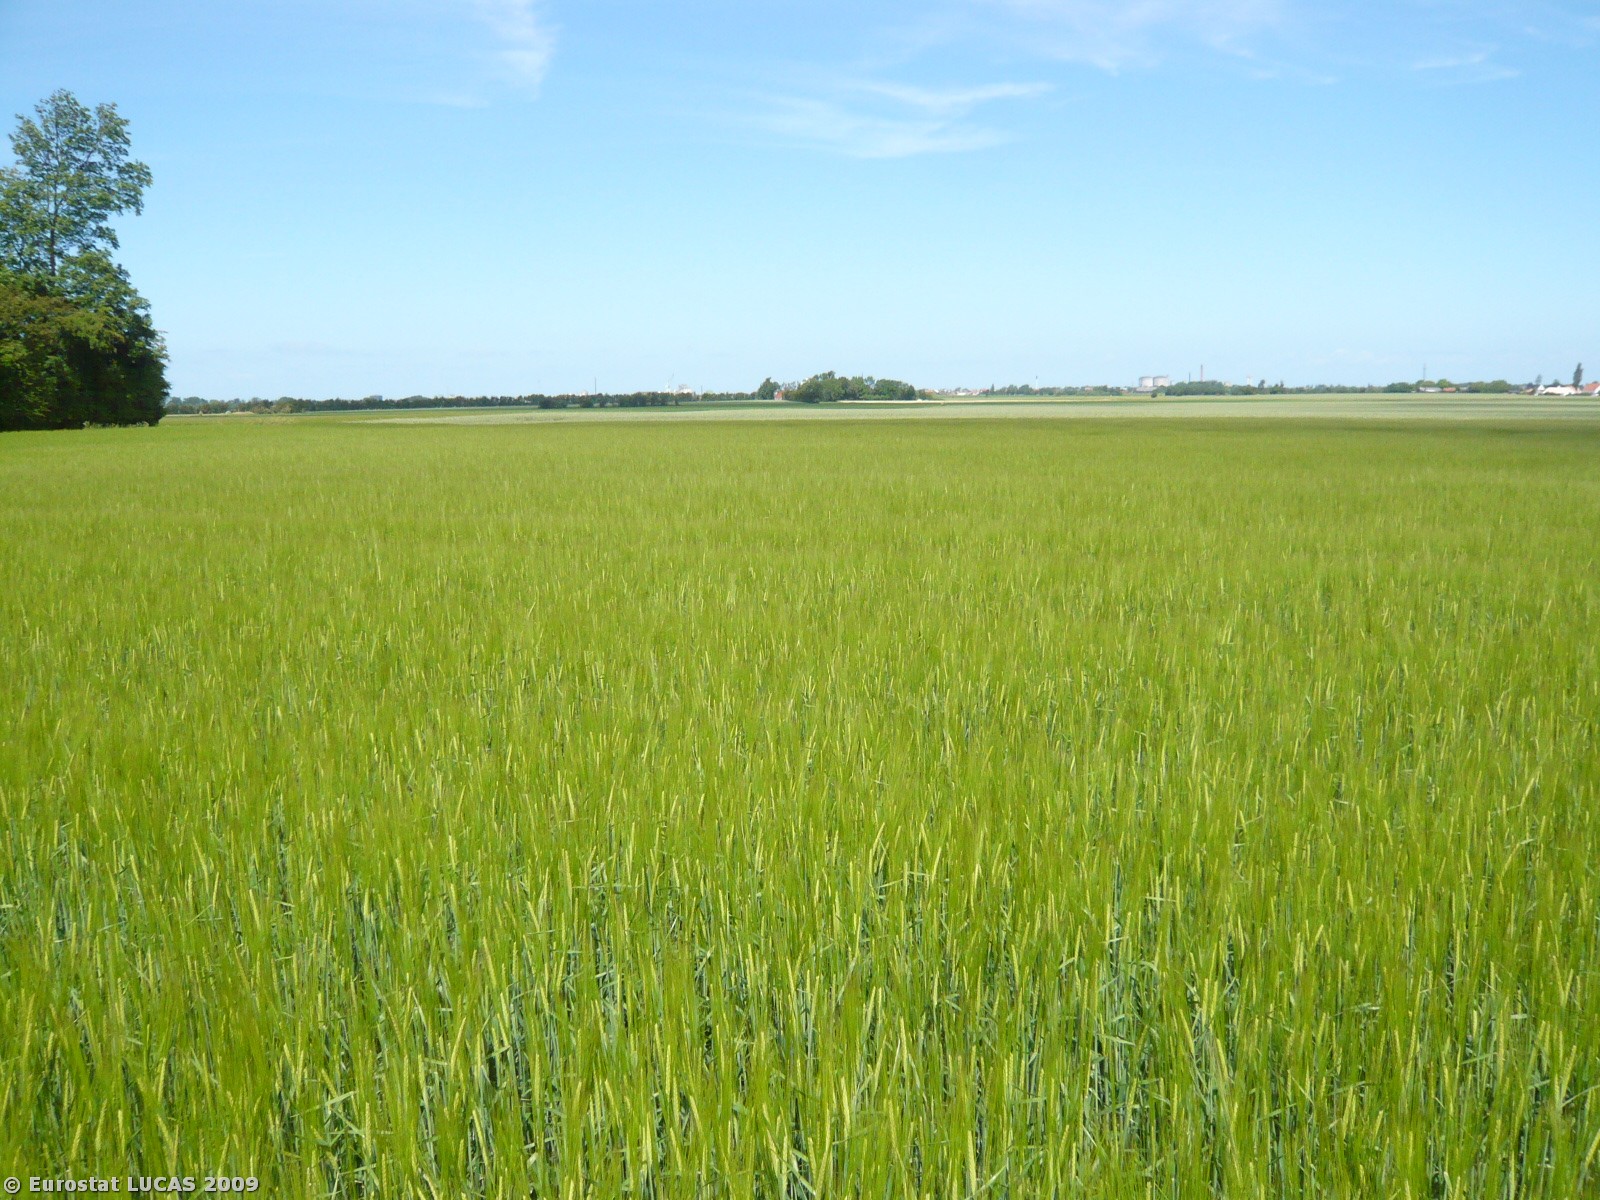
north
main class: Cropland
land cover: Barley
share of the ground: > 75 %
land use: Agriculture (excluding fallow land and kitchen gardens)
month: June
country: DK
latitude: 54.7986
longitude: 11.1347
